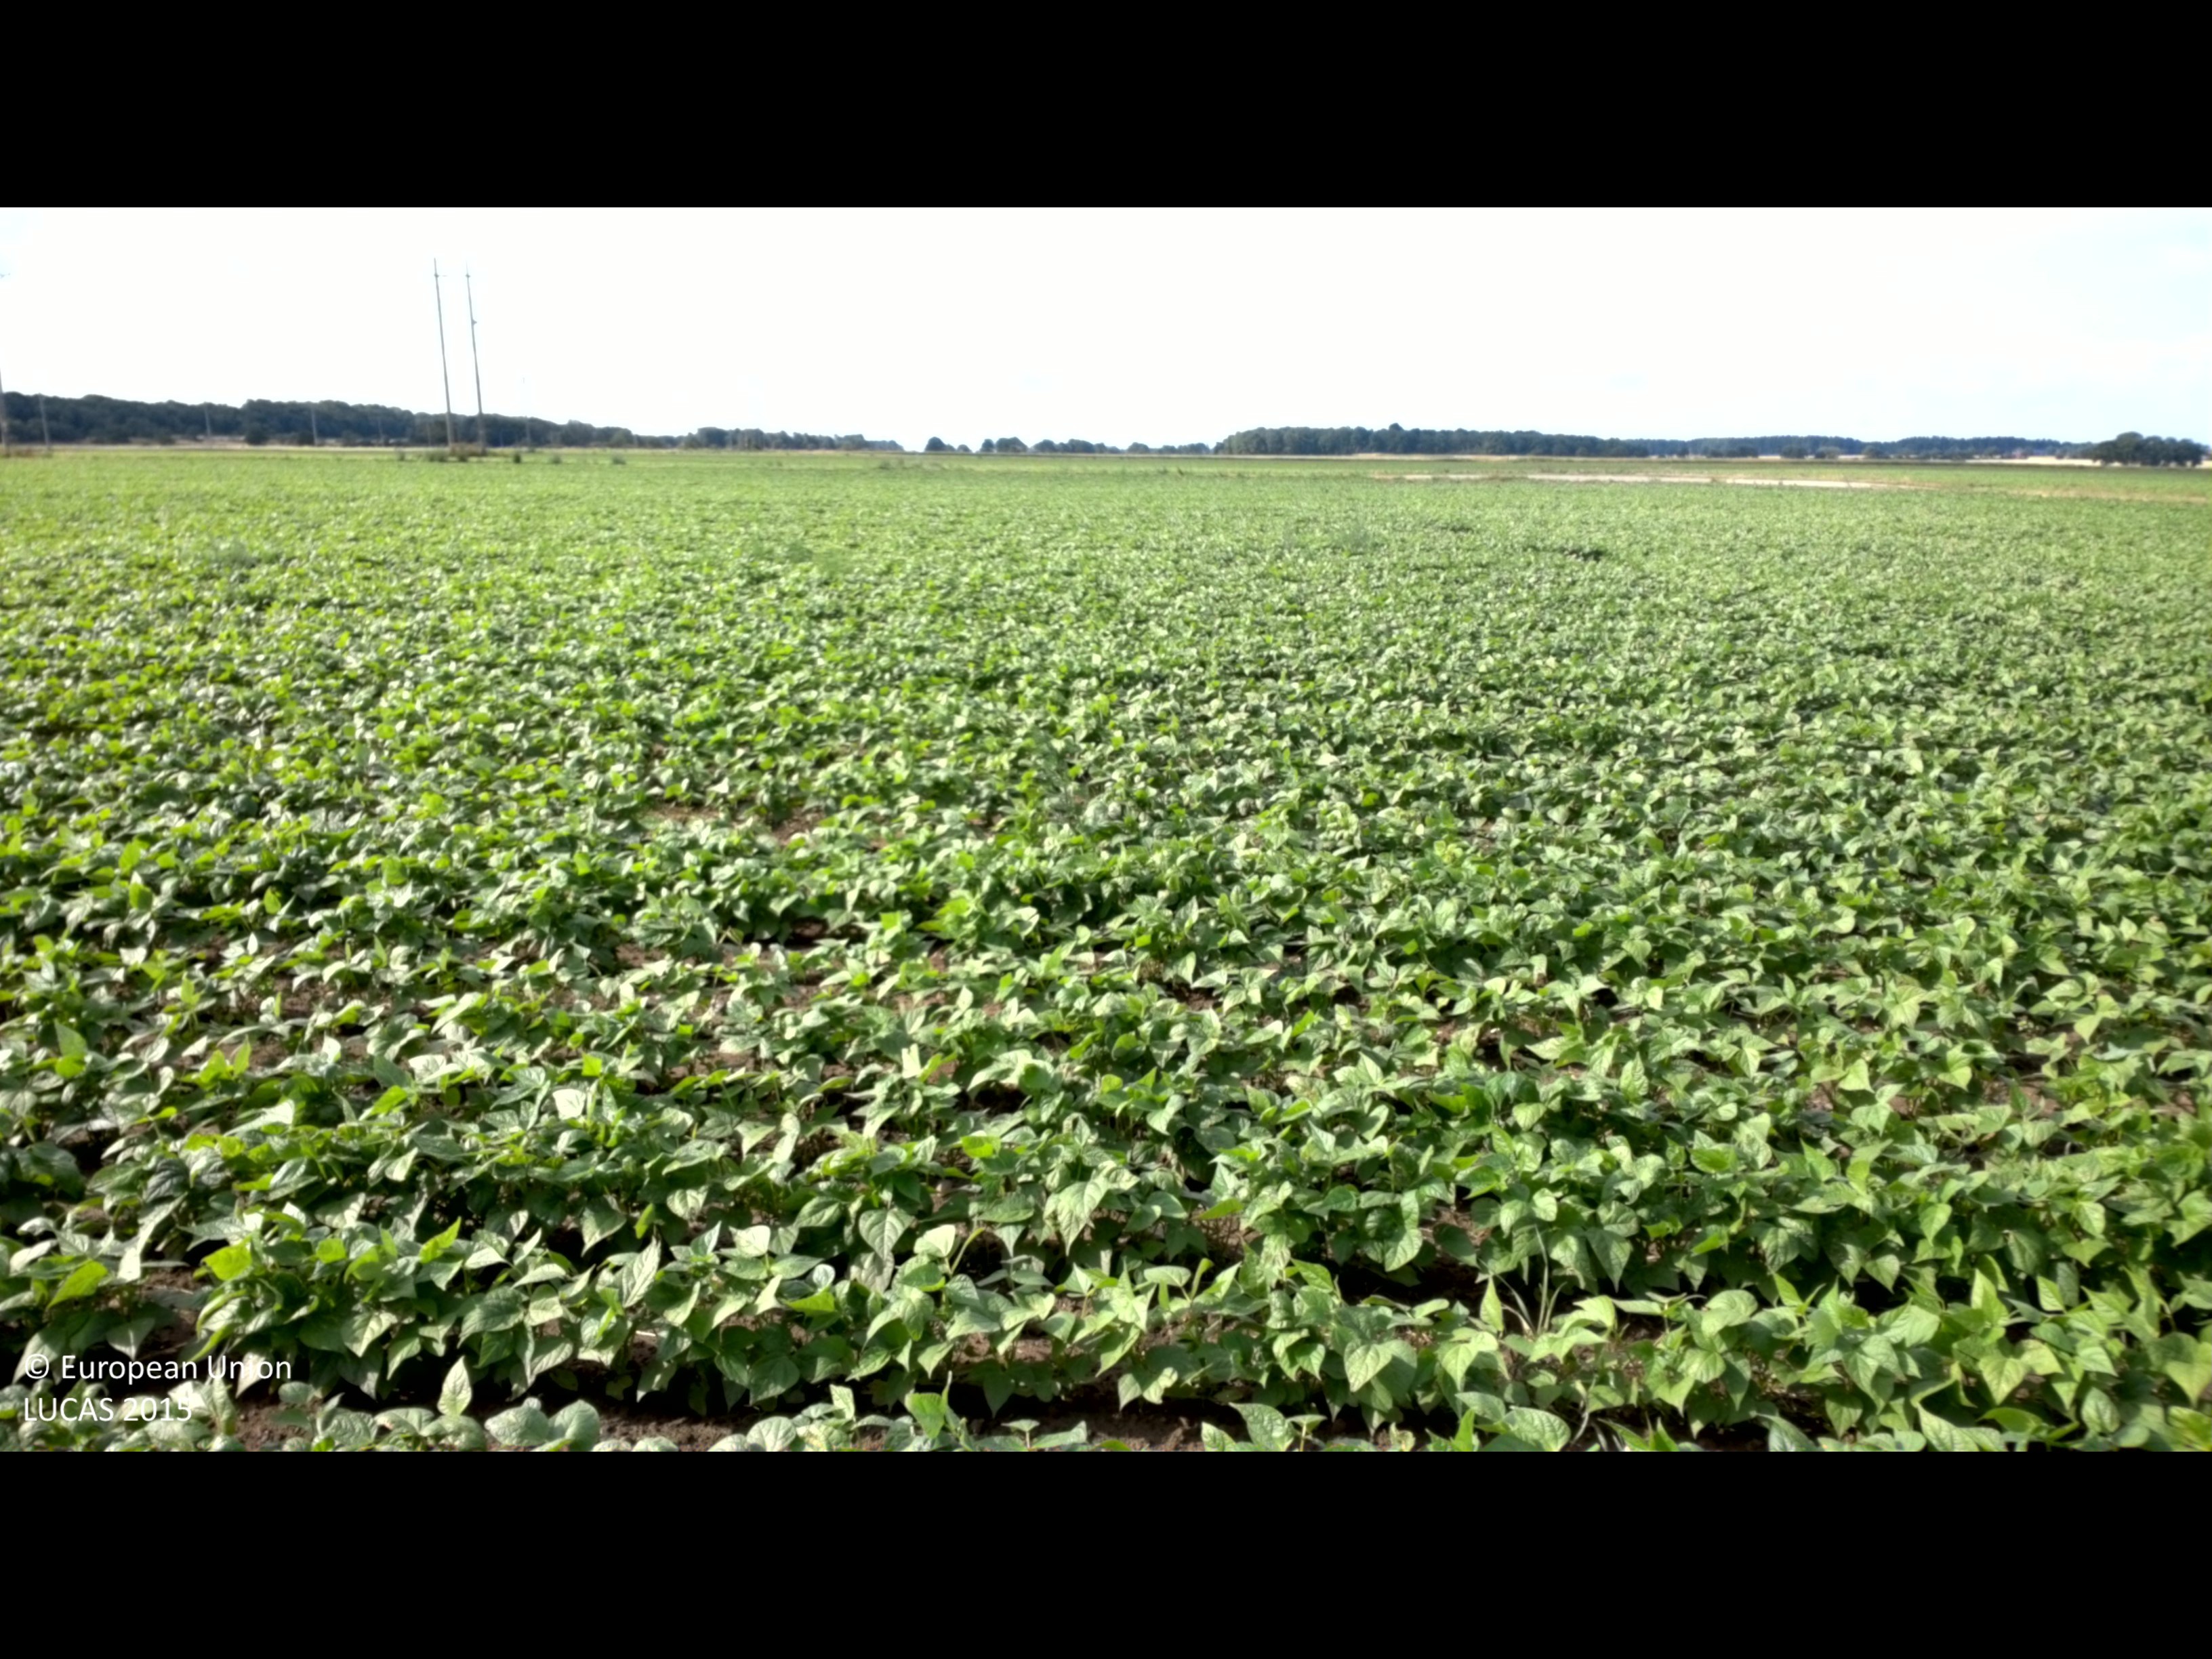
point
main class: Cropland
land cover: Dry pulses
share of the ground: > 75 %
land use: Agriculture (excluding fallow land and kitchen gardens)
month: July
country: SE
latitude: 56.5141
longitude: 16.4208
